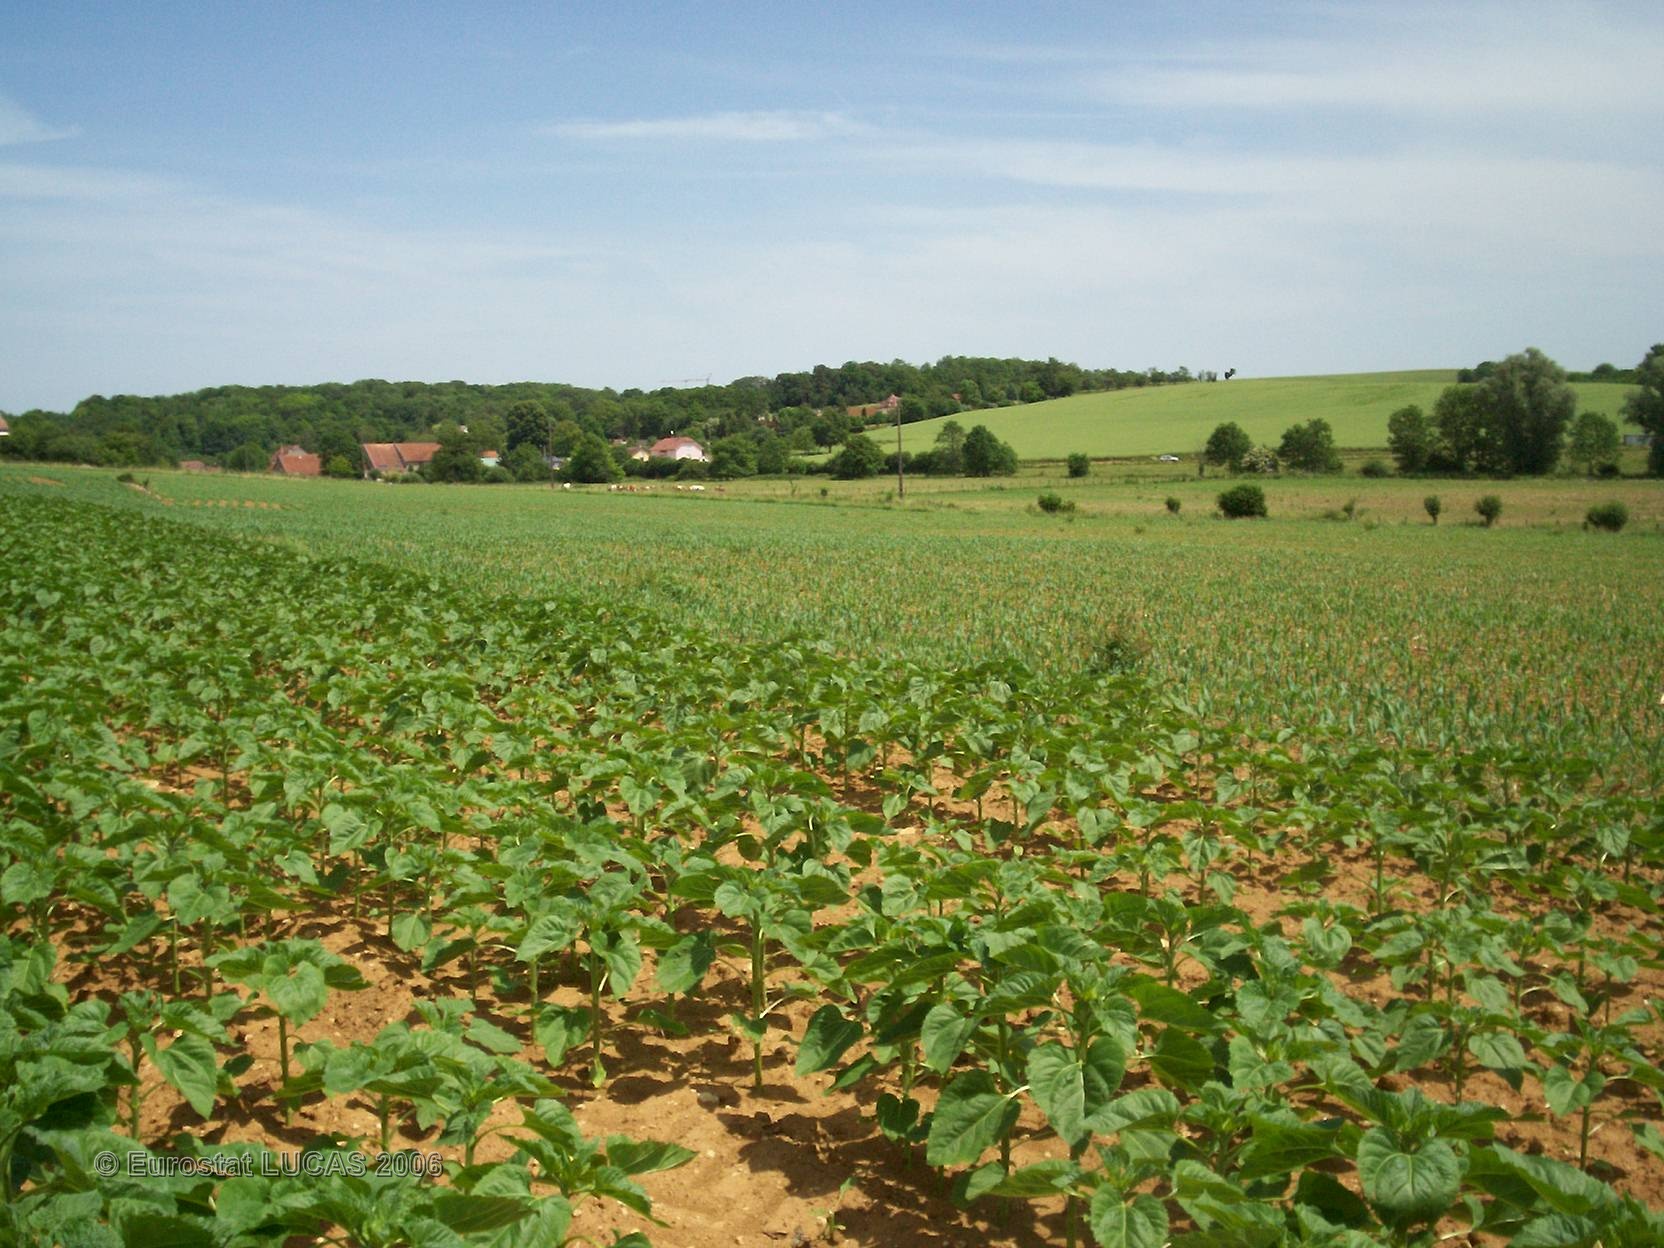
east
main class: Cropland
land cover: Sunflower
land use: Agriculture (excluding fallow land and kitchen gardens)
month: June
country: FR
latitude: 47.6671
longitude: 6.0725
